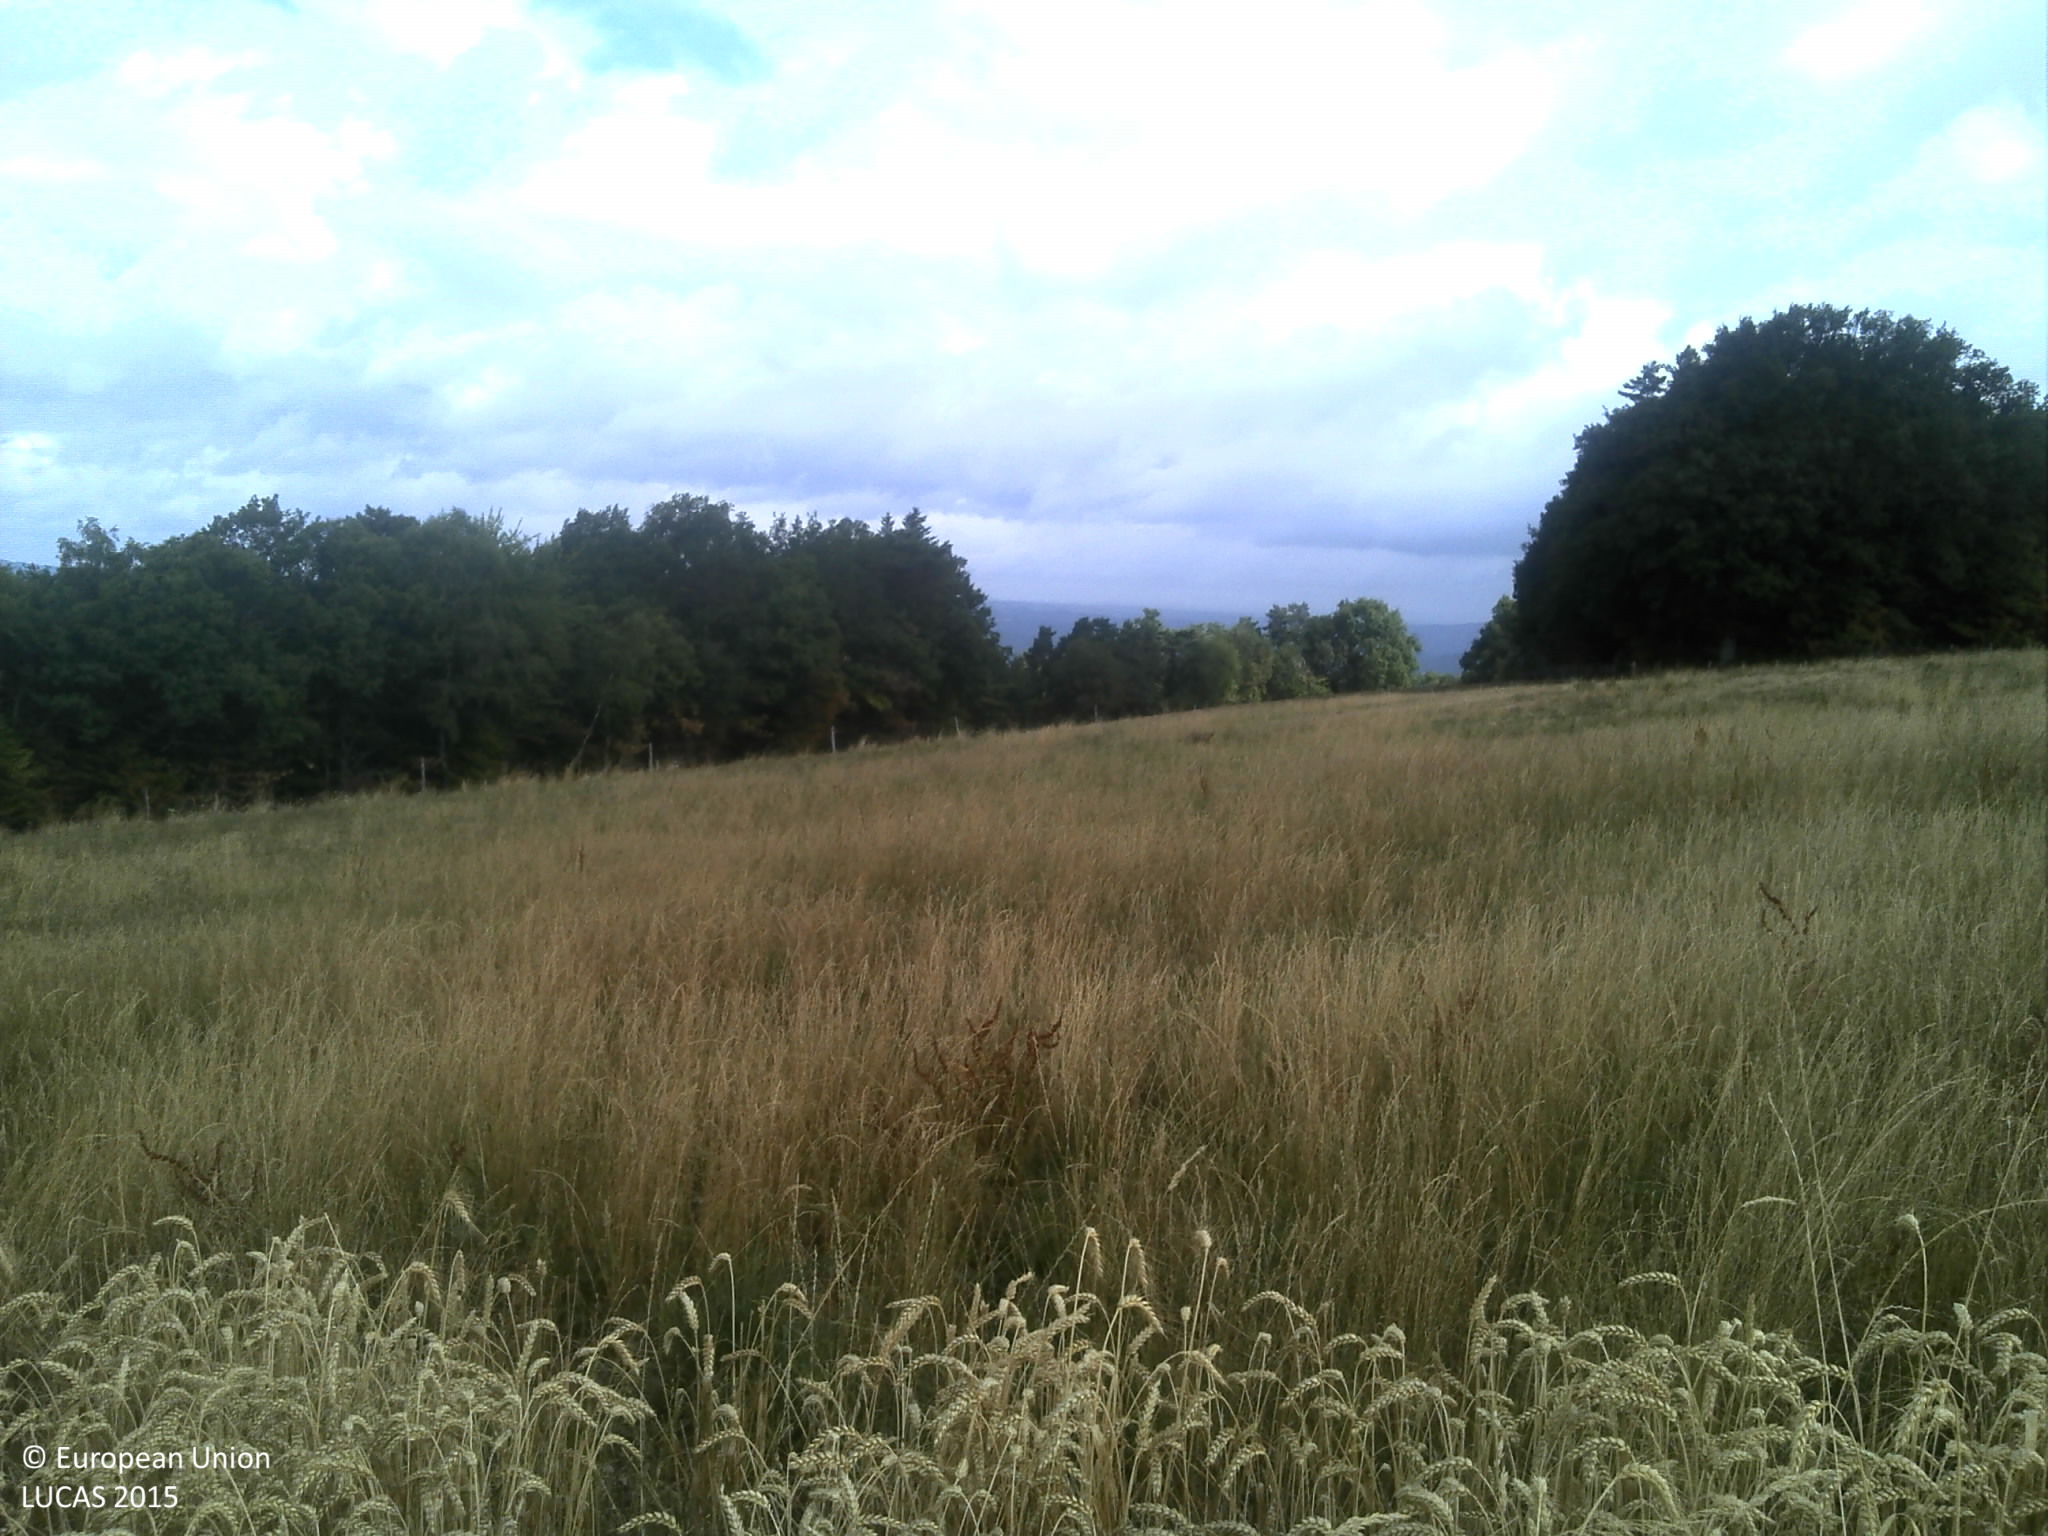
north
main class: Cropland
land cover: Common wheat
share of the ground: > 75 %
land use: Agriculture (excluding fallow land and kitchen gardens)
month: July
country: FR
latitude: 45.0507
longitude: 1.9352
